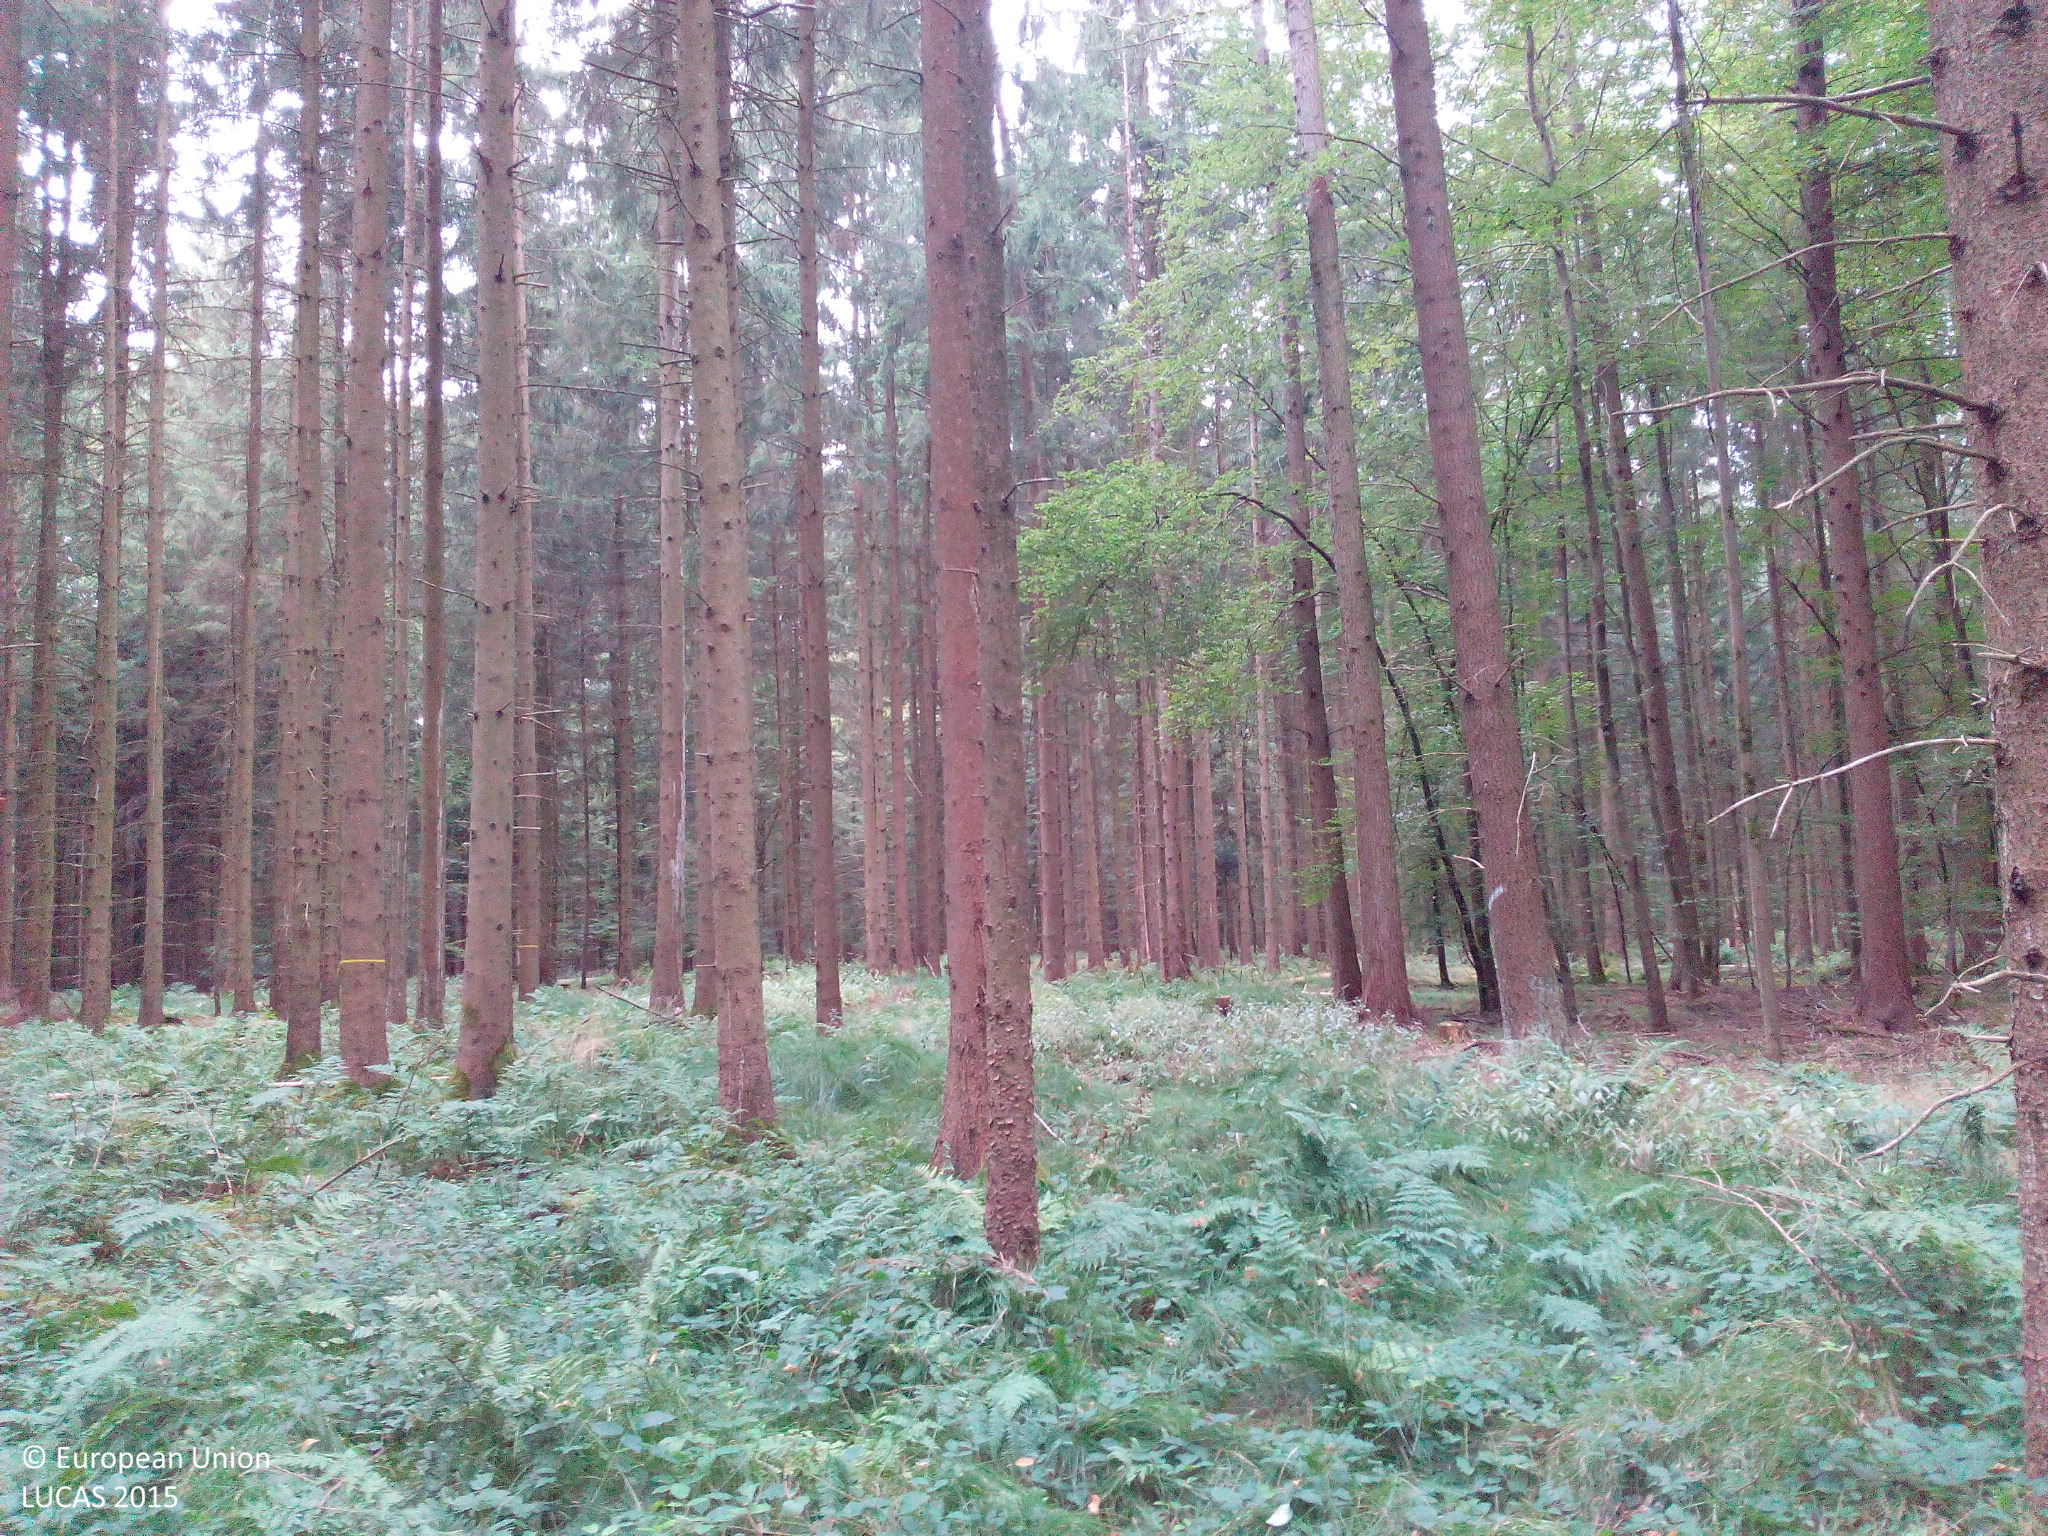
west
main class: Woodland
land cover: Spruce dominated coniferous woodland
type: hemiboreal forest and nemoral coniferous forest and mixed broadleaved-coniferous forest
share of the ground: > 75 %
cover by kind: coniferous forest trees 80 %, broadleaved forest trees 10 %, lichens and mosses 10 %
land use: Forestry
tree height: > 5 m
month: September
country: DE
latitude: 48.4742
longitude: 10.5273
